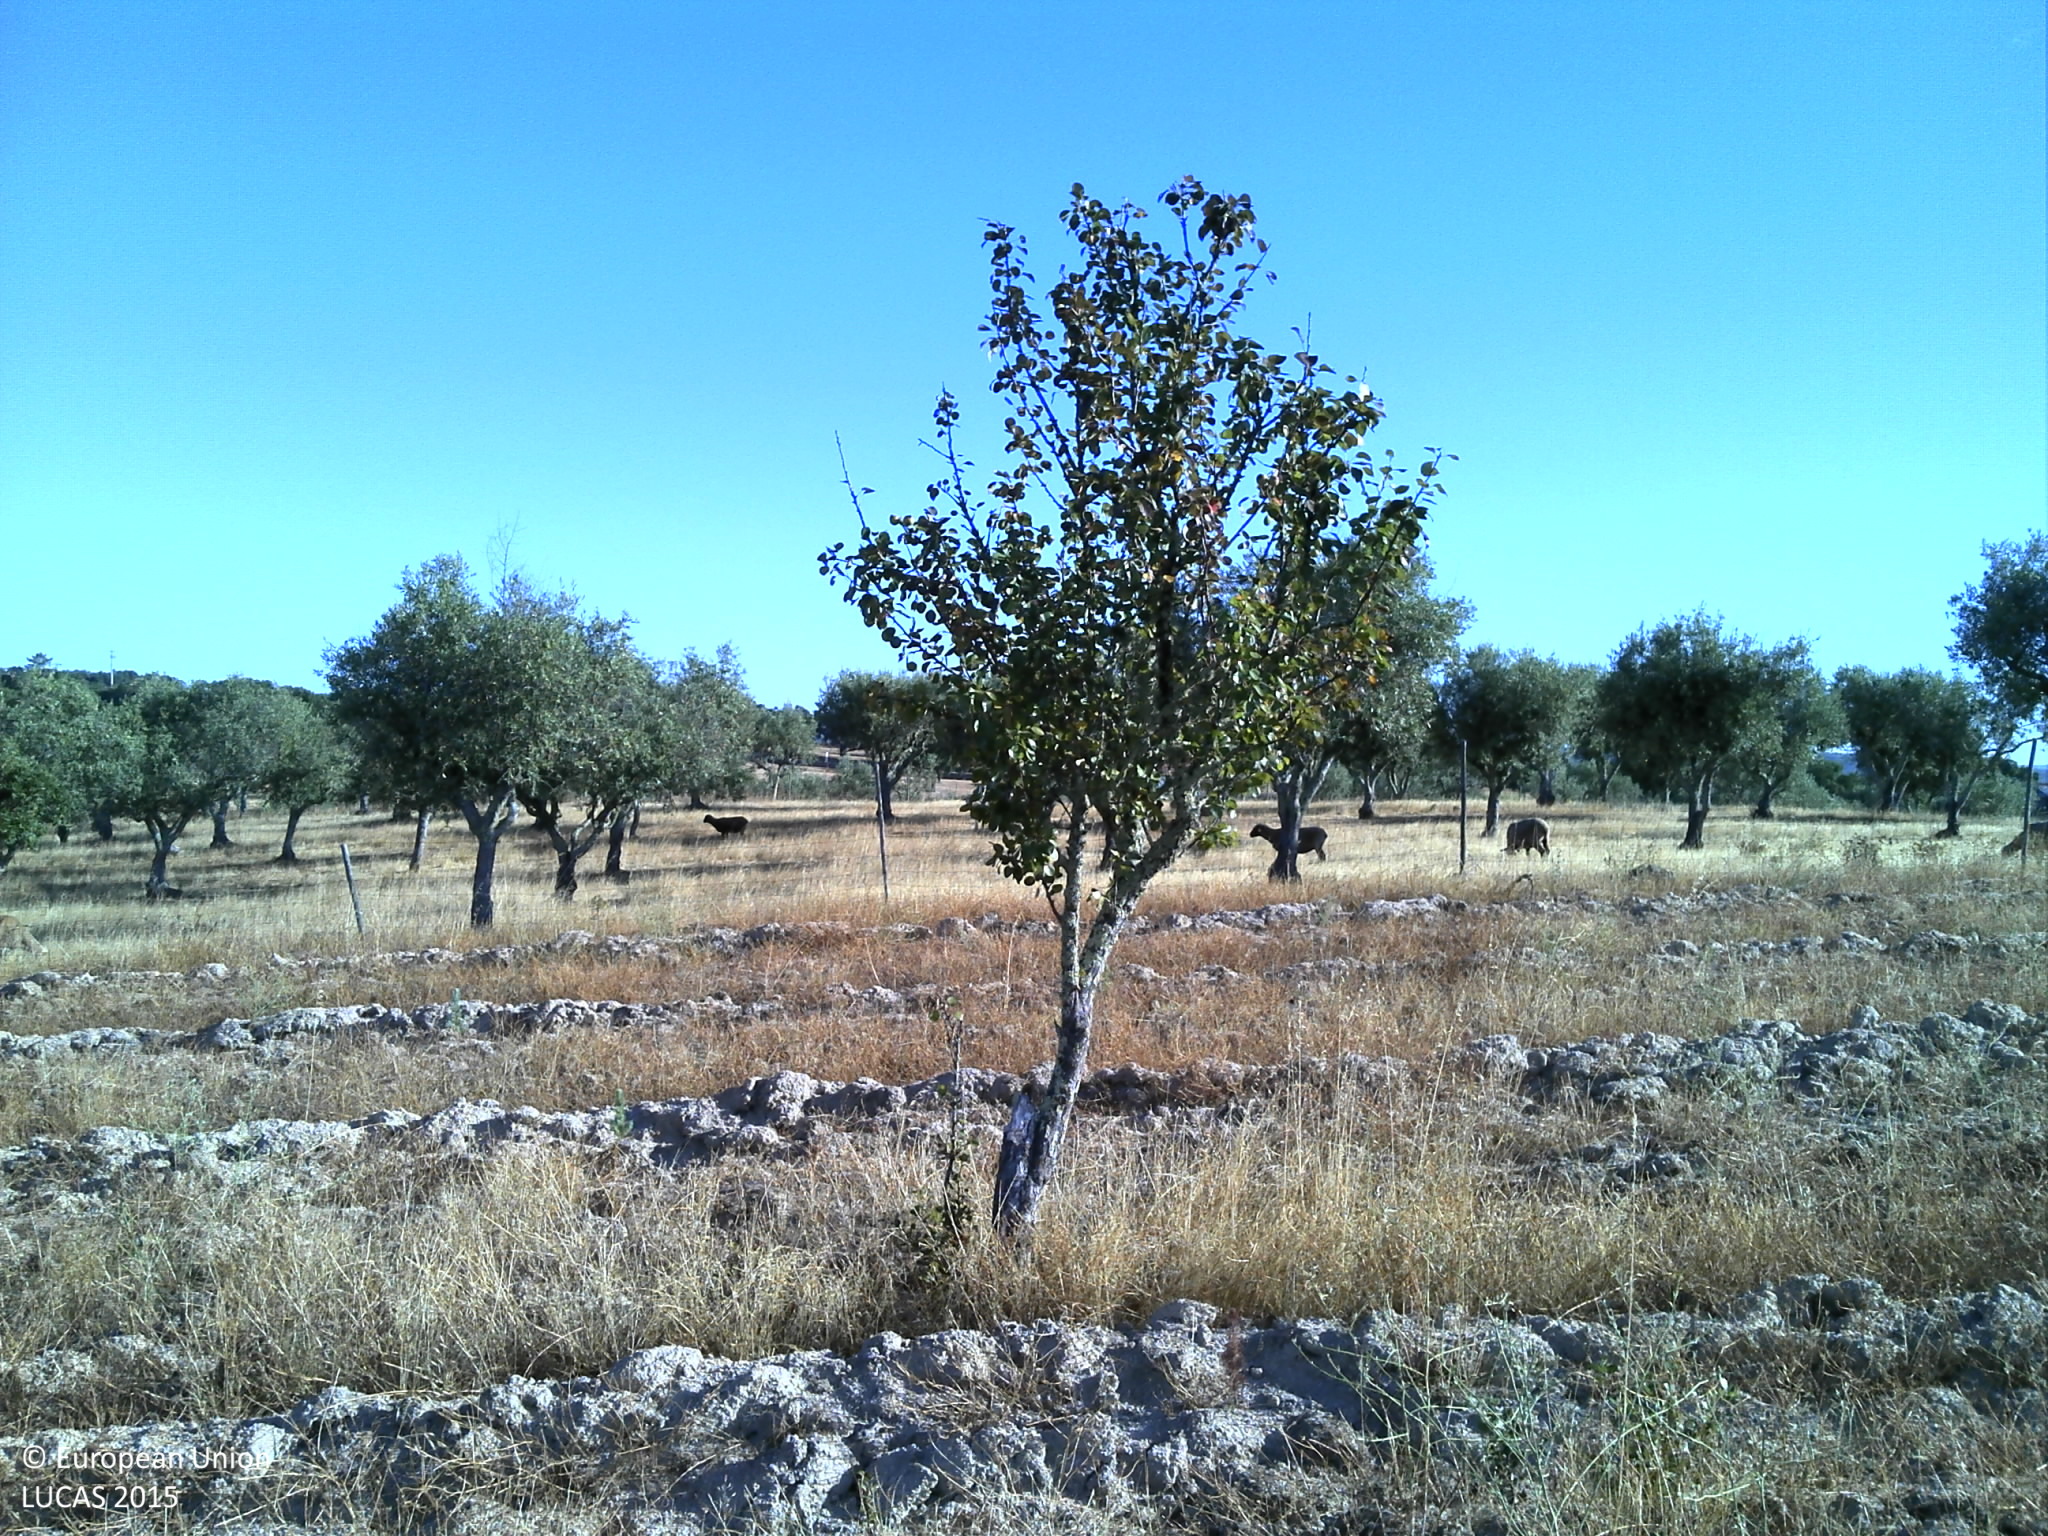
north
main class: Grassland
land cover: Grassland with sparse tree/shrub cover
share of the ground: < 10 %
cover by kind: herbaceous plants 60 %, unconsolidated bare surface 35 %, coniferous forest trees 5 %
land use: Forestry
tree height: < 5 m
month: August
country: PT
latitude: 39.5257
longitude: -7.7236
